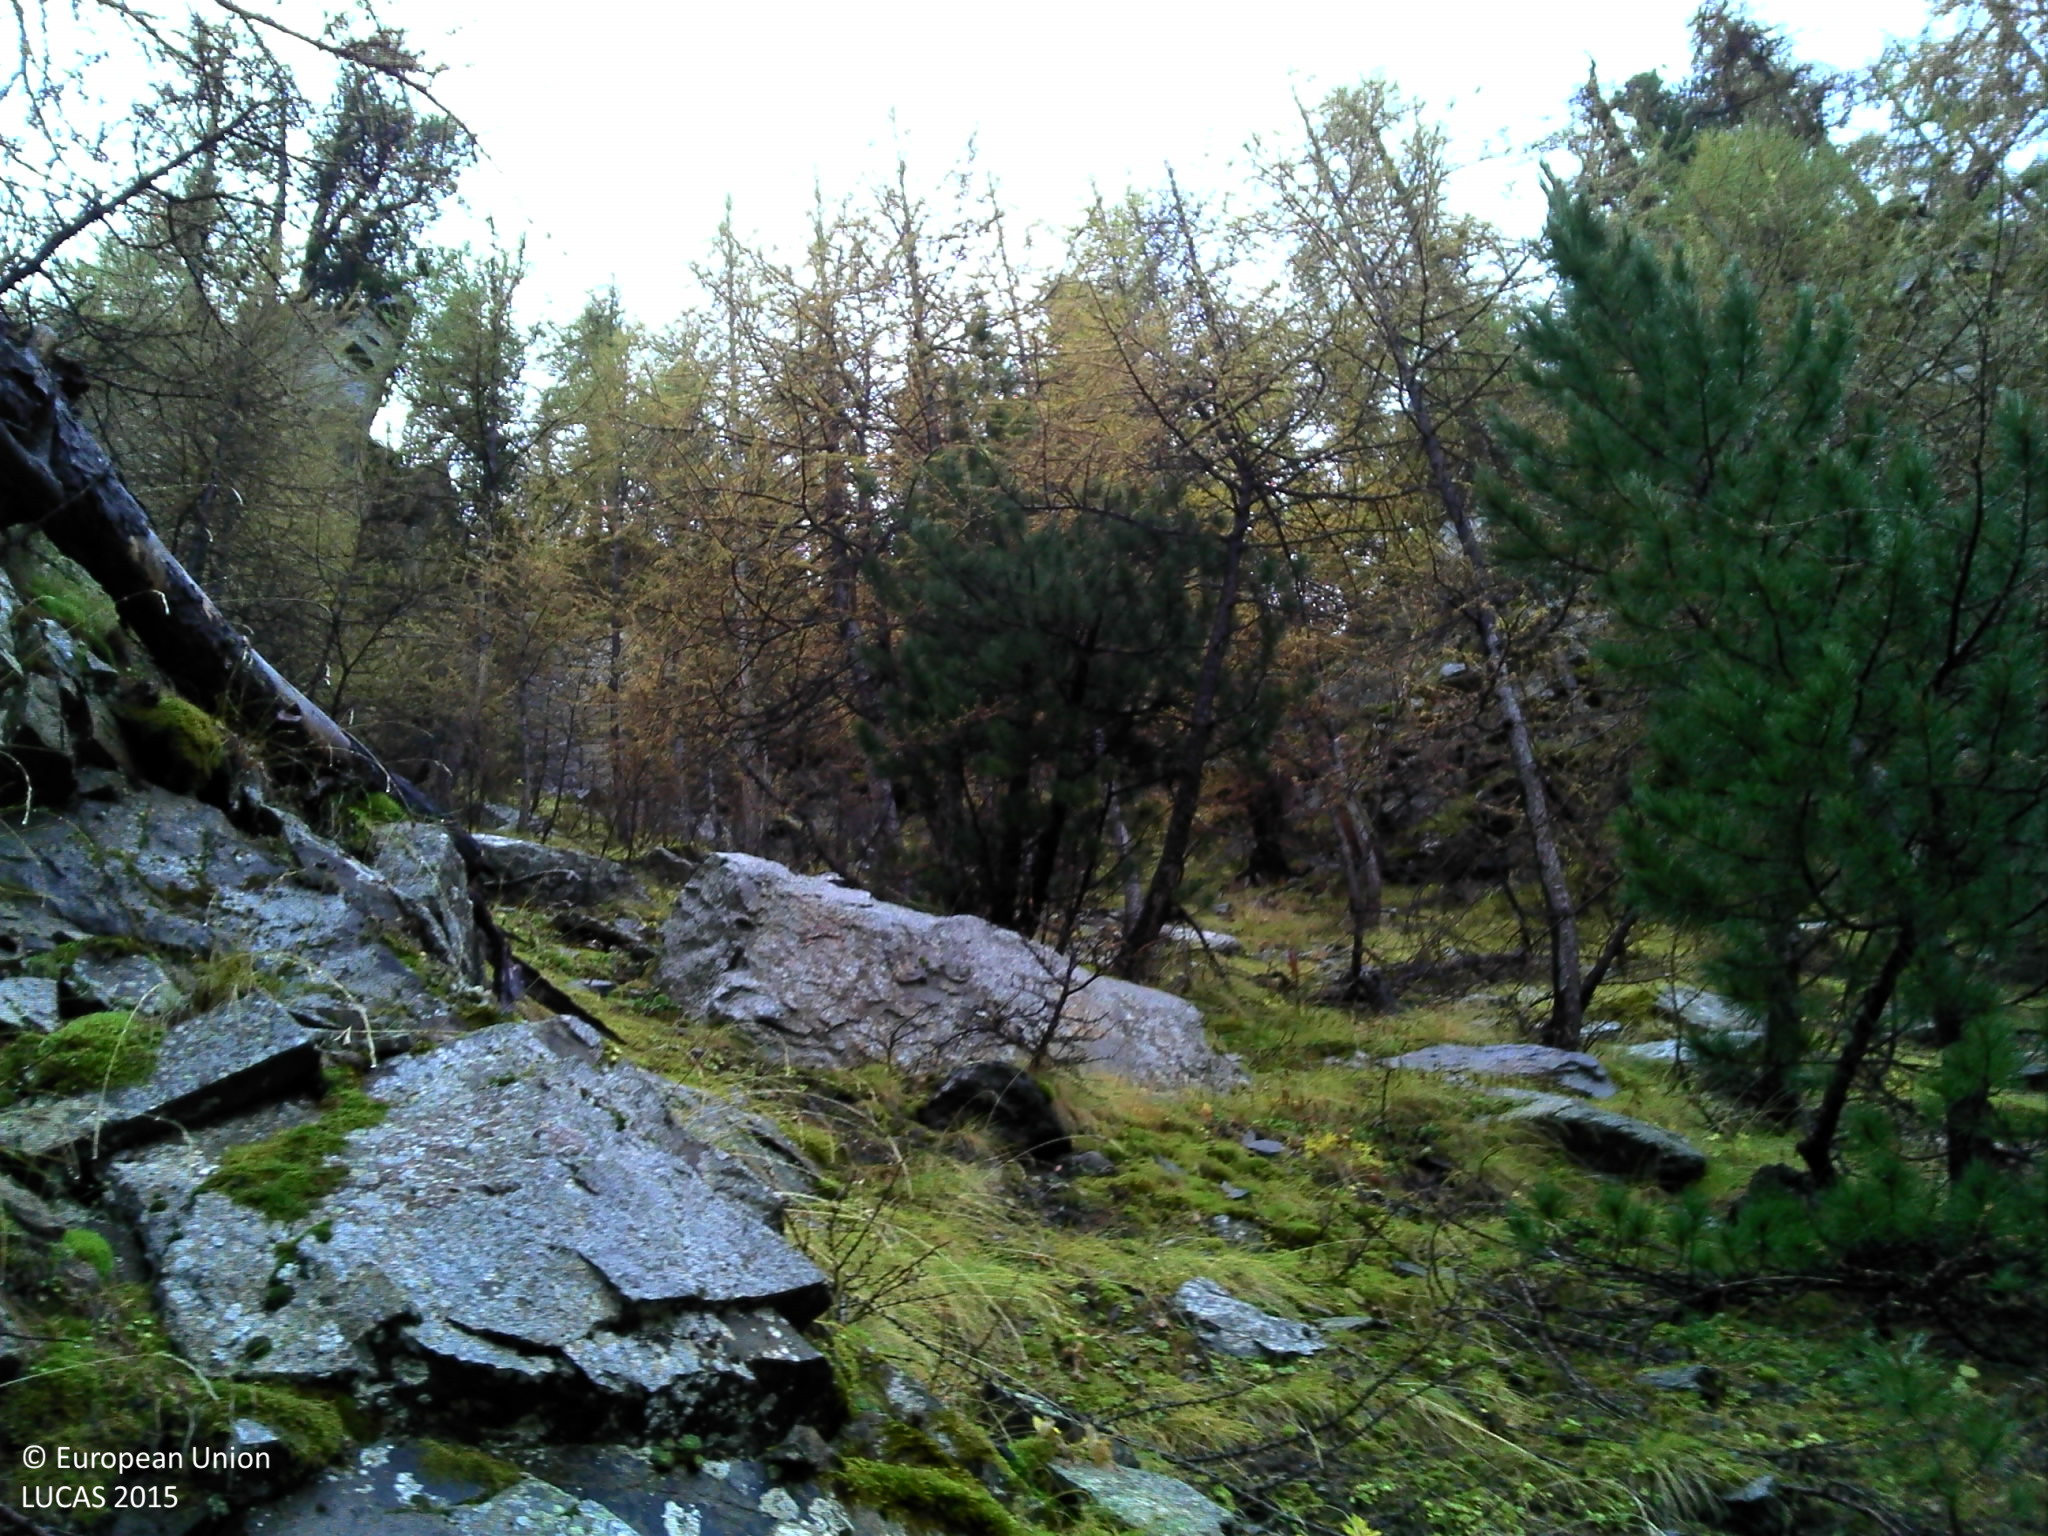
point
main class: Woodland
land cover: Pine dominated coniferous woodland
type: alpine coniferous forest
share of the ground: > 75 %
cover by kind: coniferous forest trees 70 %, herbaceous plants 15 %, consolidated bare surface 15 %
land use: Semi-natural and natural areas not in use
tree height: > 5 m
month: October
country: FR
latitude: 45.0328
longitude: 6.5401
